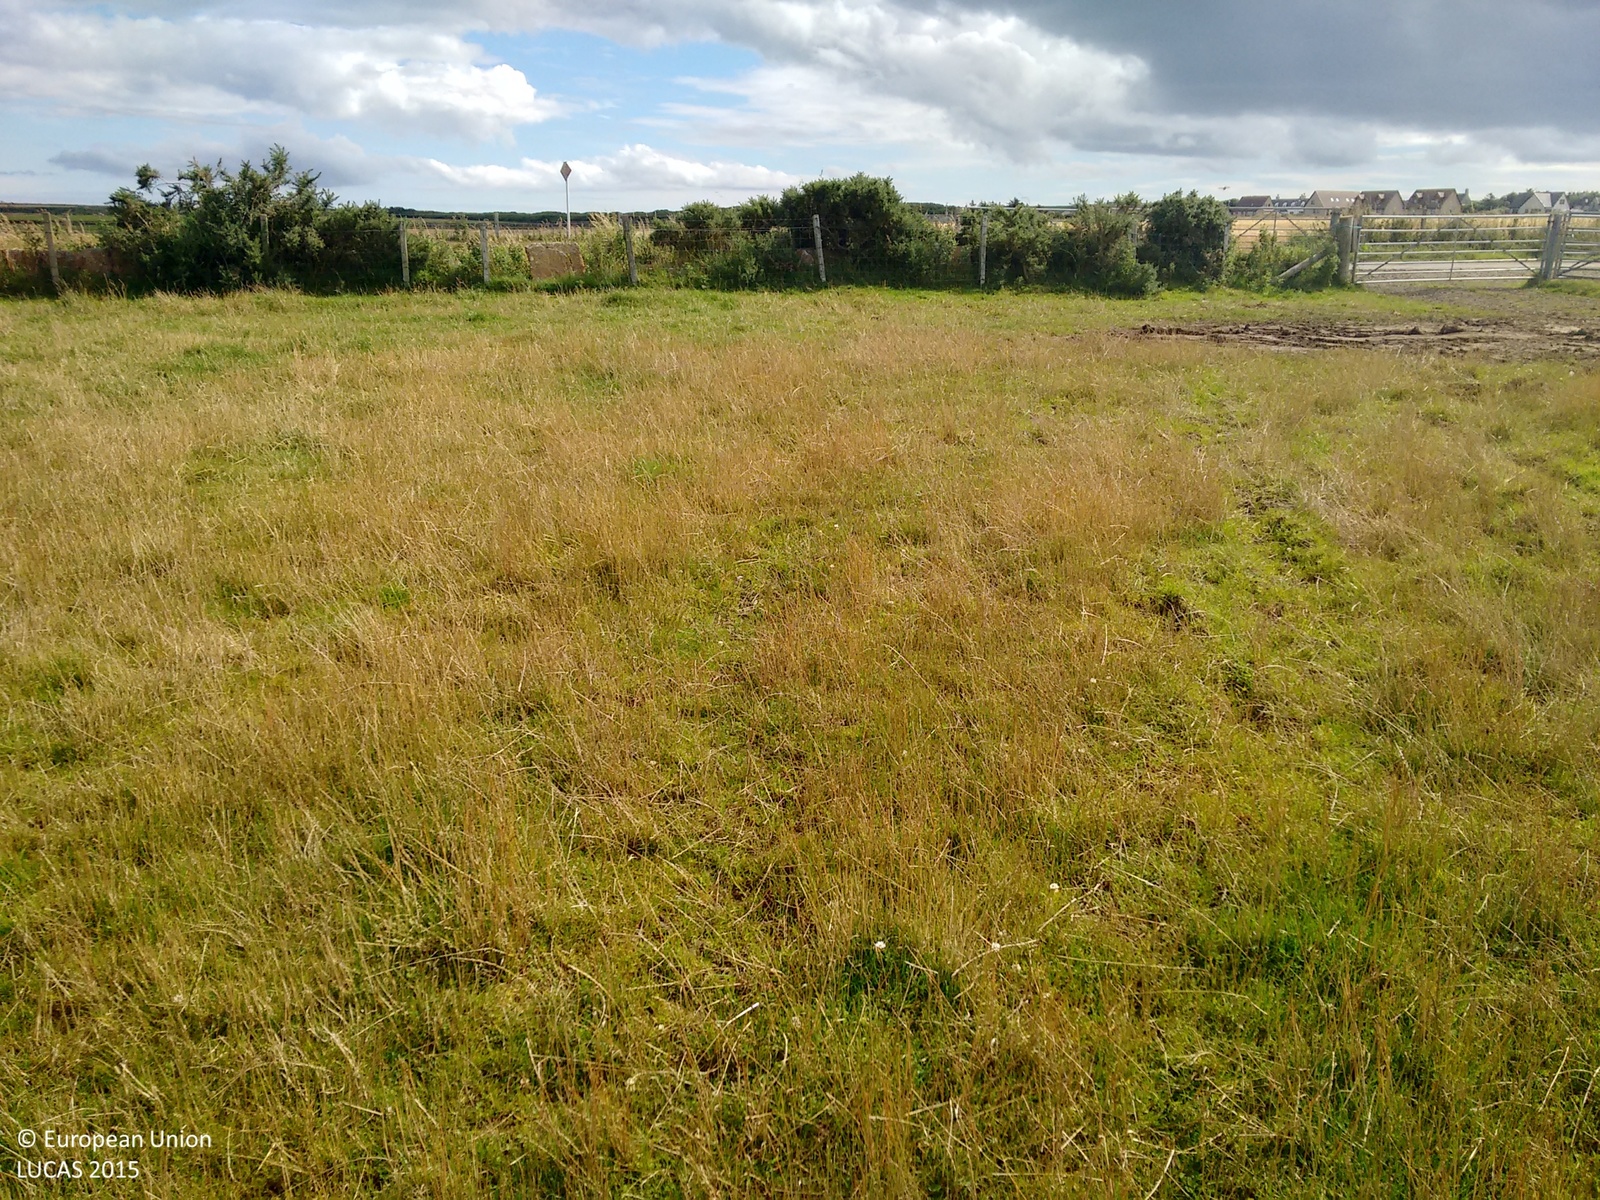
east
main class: Grassland
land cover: Grassland without tree/shrub cover
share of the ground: > 75 %
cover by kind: herbaceous plants 100 %
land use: Agriculture (excluding fallow land and kitchen gardens)
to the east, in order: Grassland without tree/shrub cover; Fences; Abandoned hedges; Grass margins; Paved roads, cycling and walking lanes; Grass margins; Abandoned hedges; Fences; Grassland without tree/shrub cover; Fences; Grass margins; Barley; Grass margins; Fences; Grassland without tree/shrub cover
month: August
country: GB
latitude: 58.6388
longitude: -3.2378
